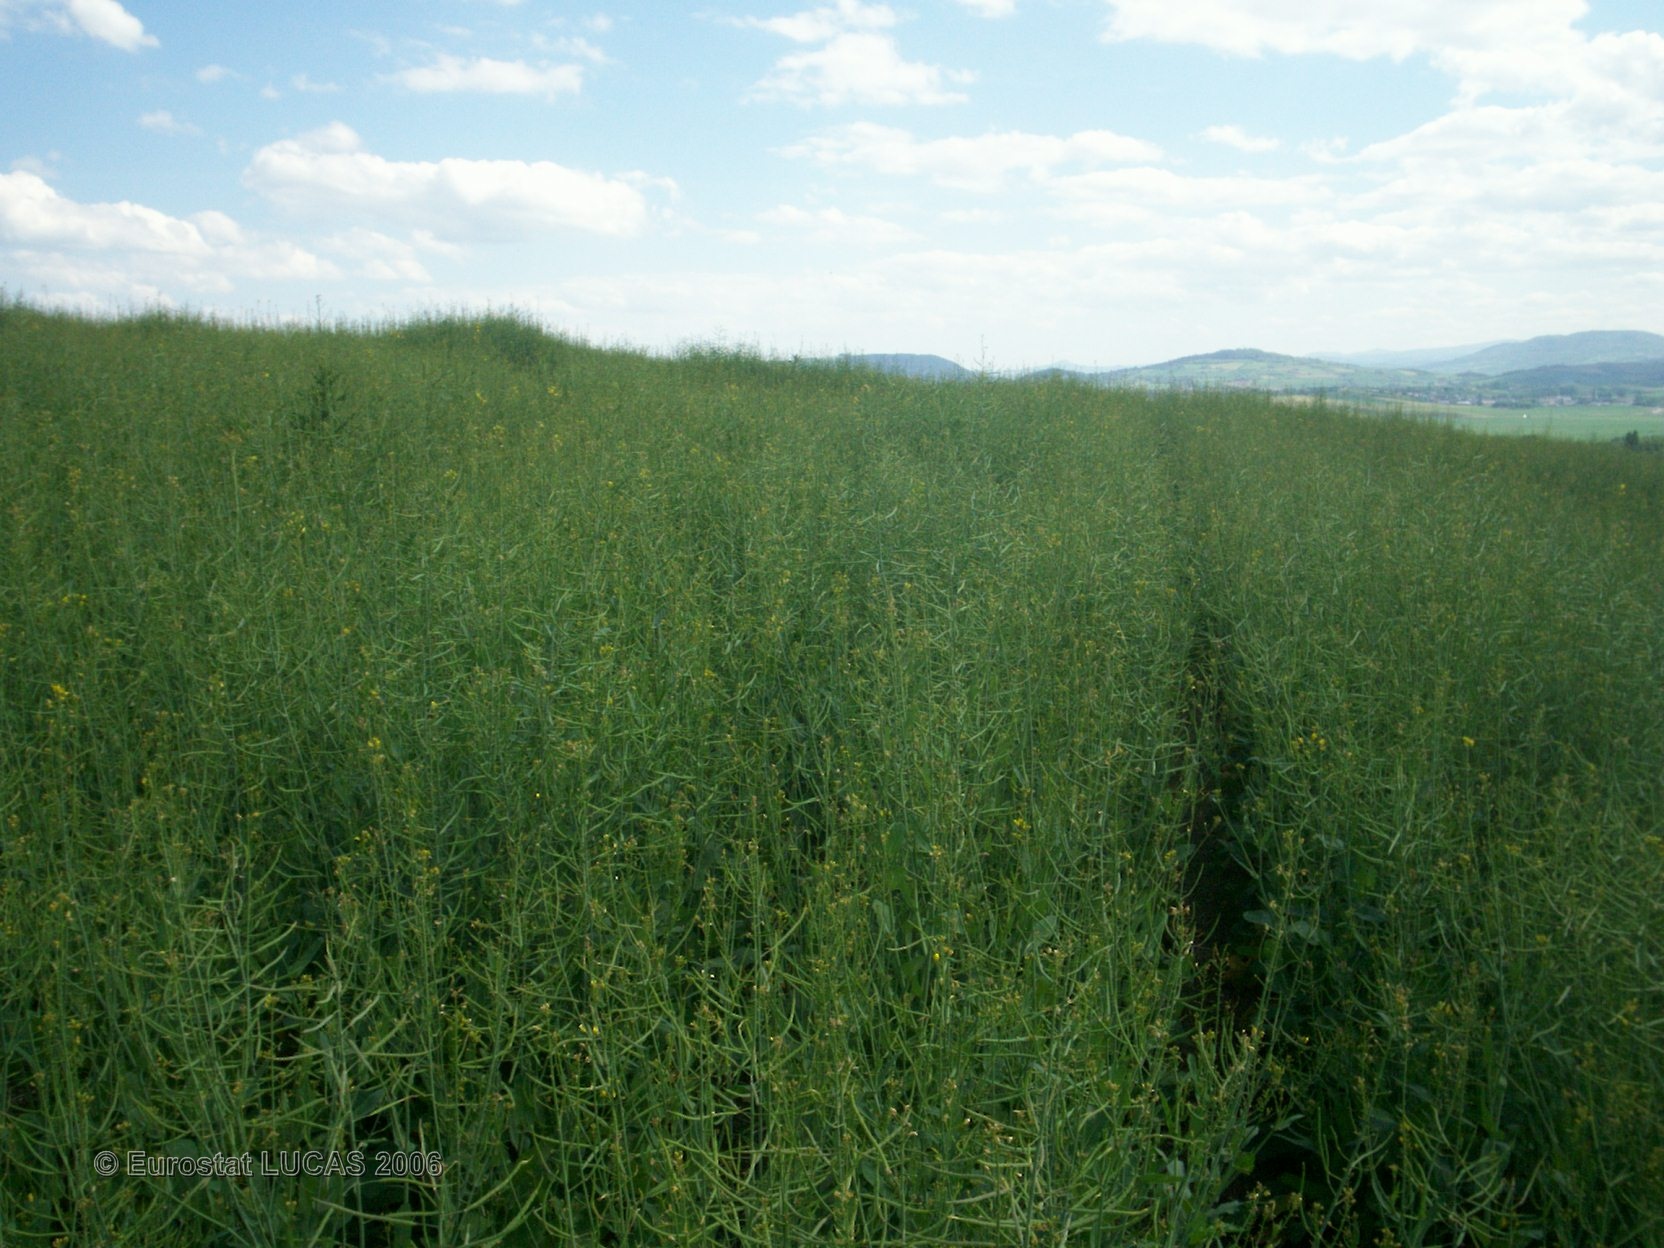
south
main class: Cropland
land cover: Rape and turnip rape
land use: Agriculture (excluding fallow land and kitchen gardens)
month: May
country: FR
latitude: 45.7535
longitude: 3.1738
